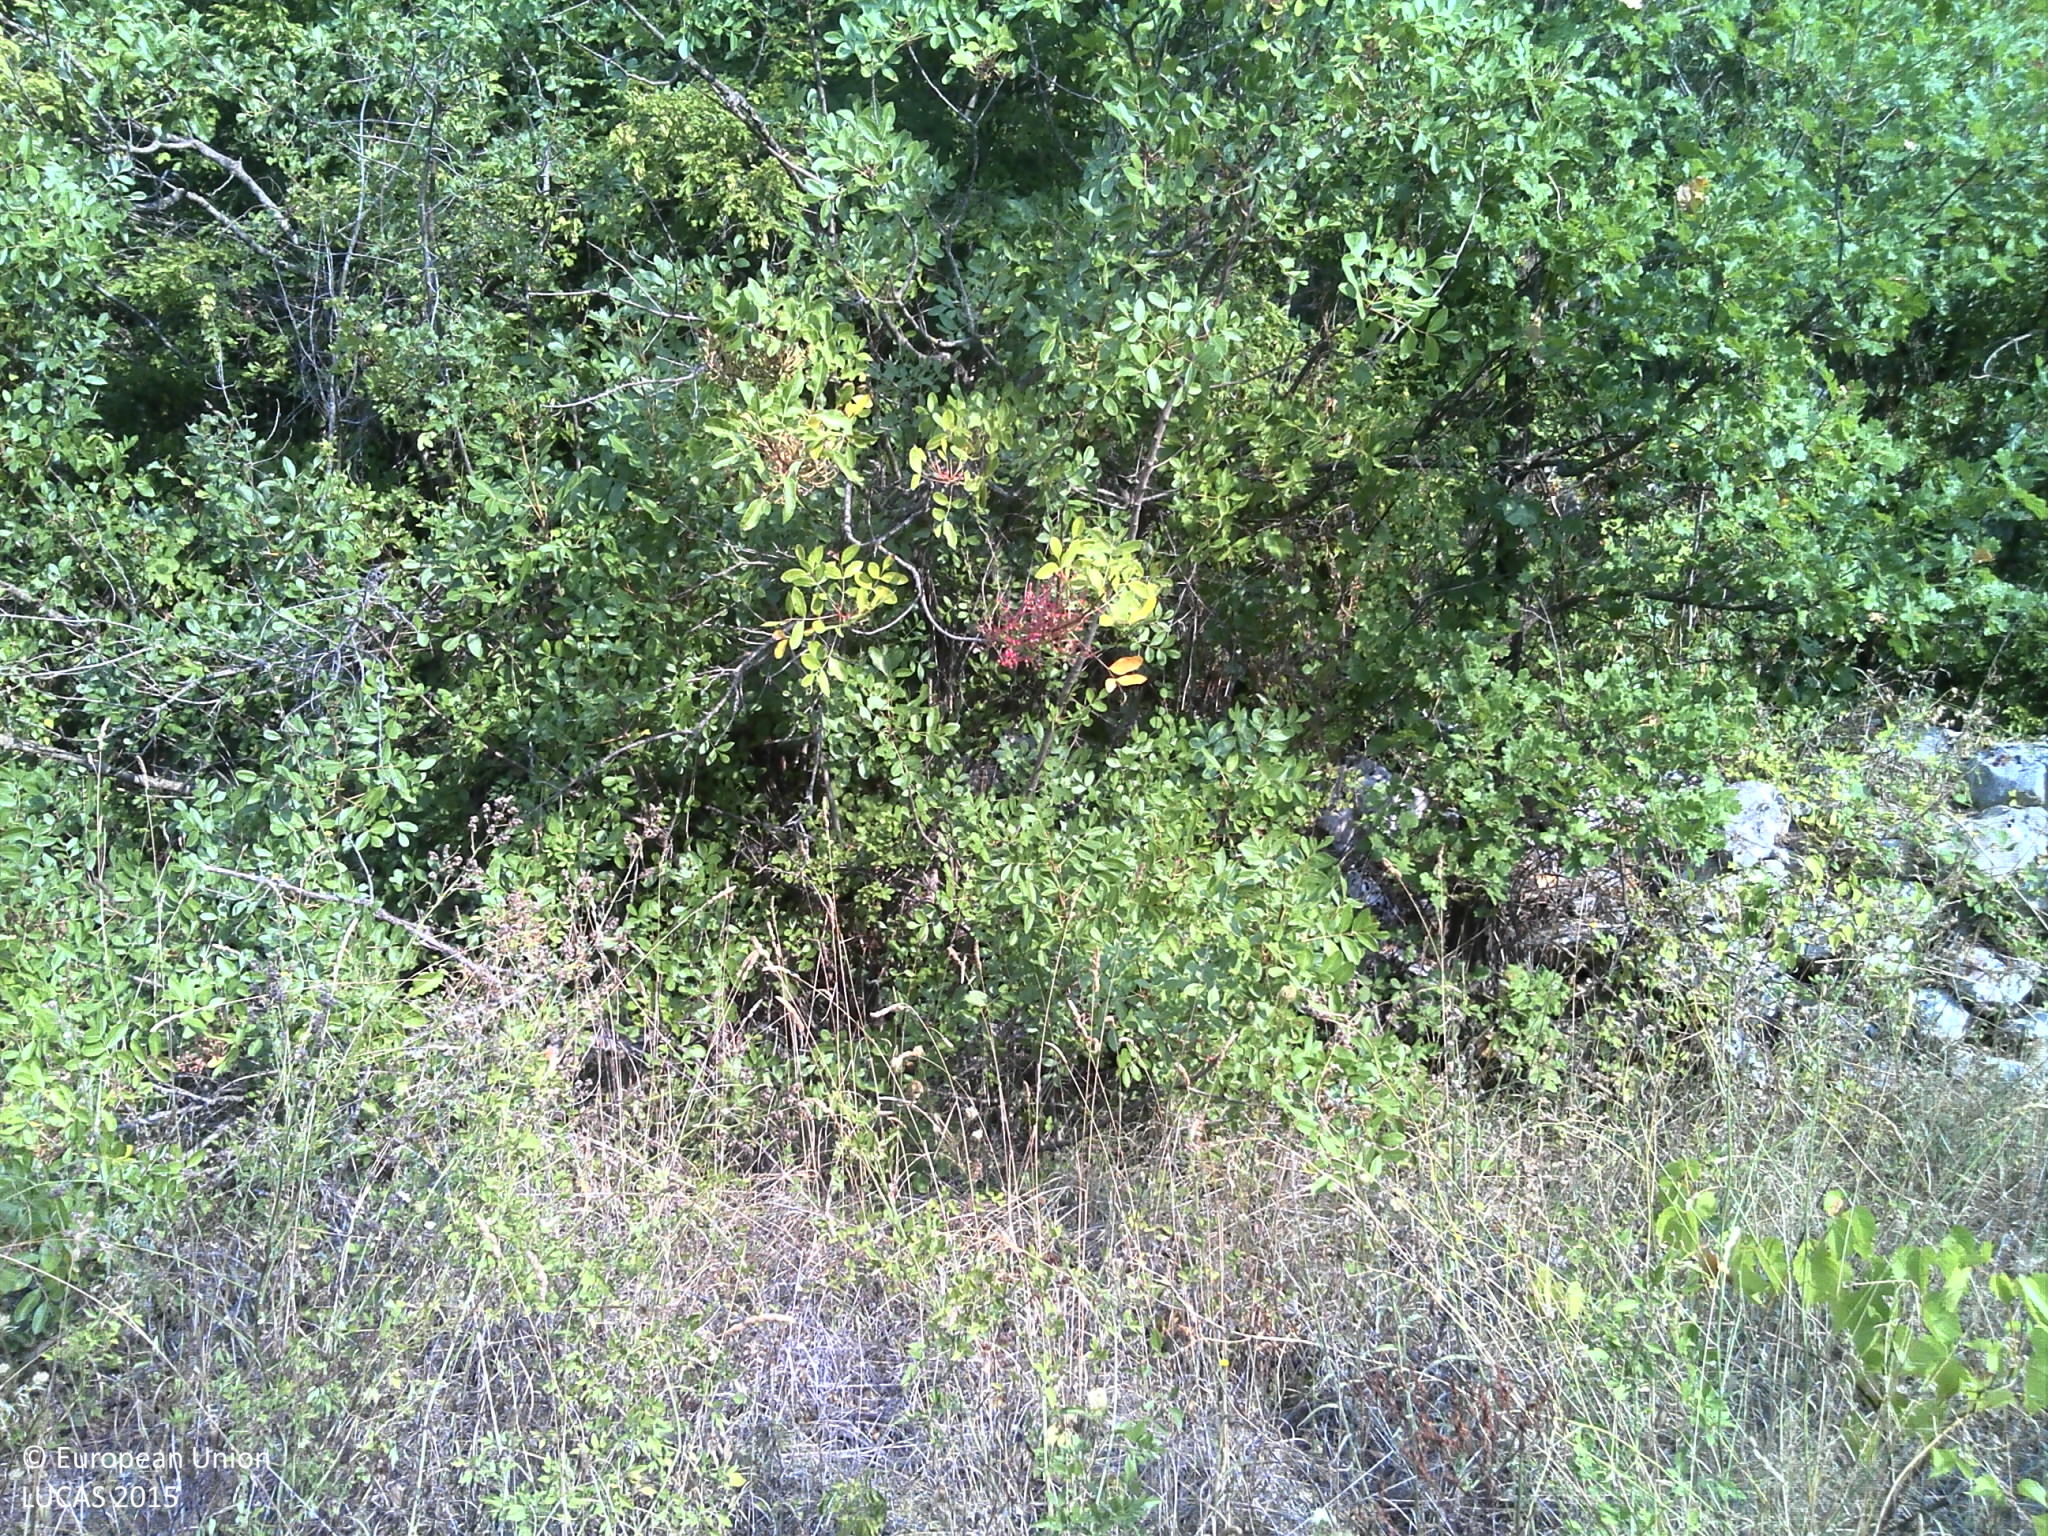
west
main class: Grassland
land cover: Grassland with sparse tree/shrub cover
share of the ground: > 75 %
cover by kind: herbaceous plants 80 %, shrubs 10 %, broadleaved forest trees 5 %, consolidated bare surface 5 %
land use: Abandoned areas
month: August
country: HR
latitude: 43.2281
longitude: 17.2430
